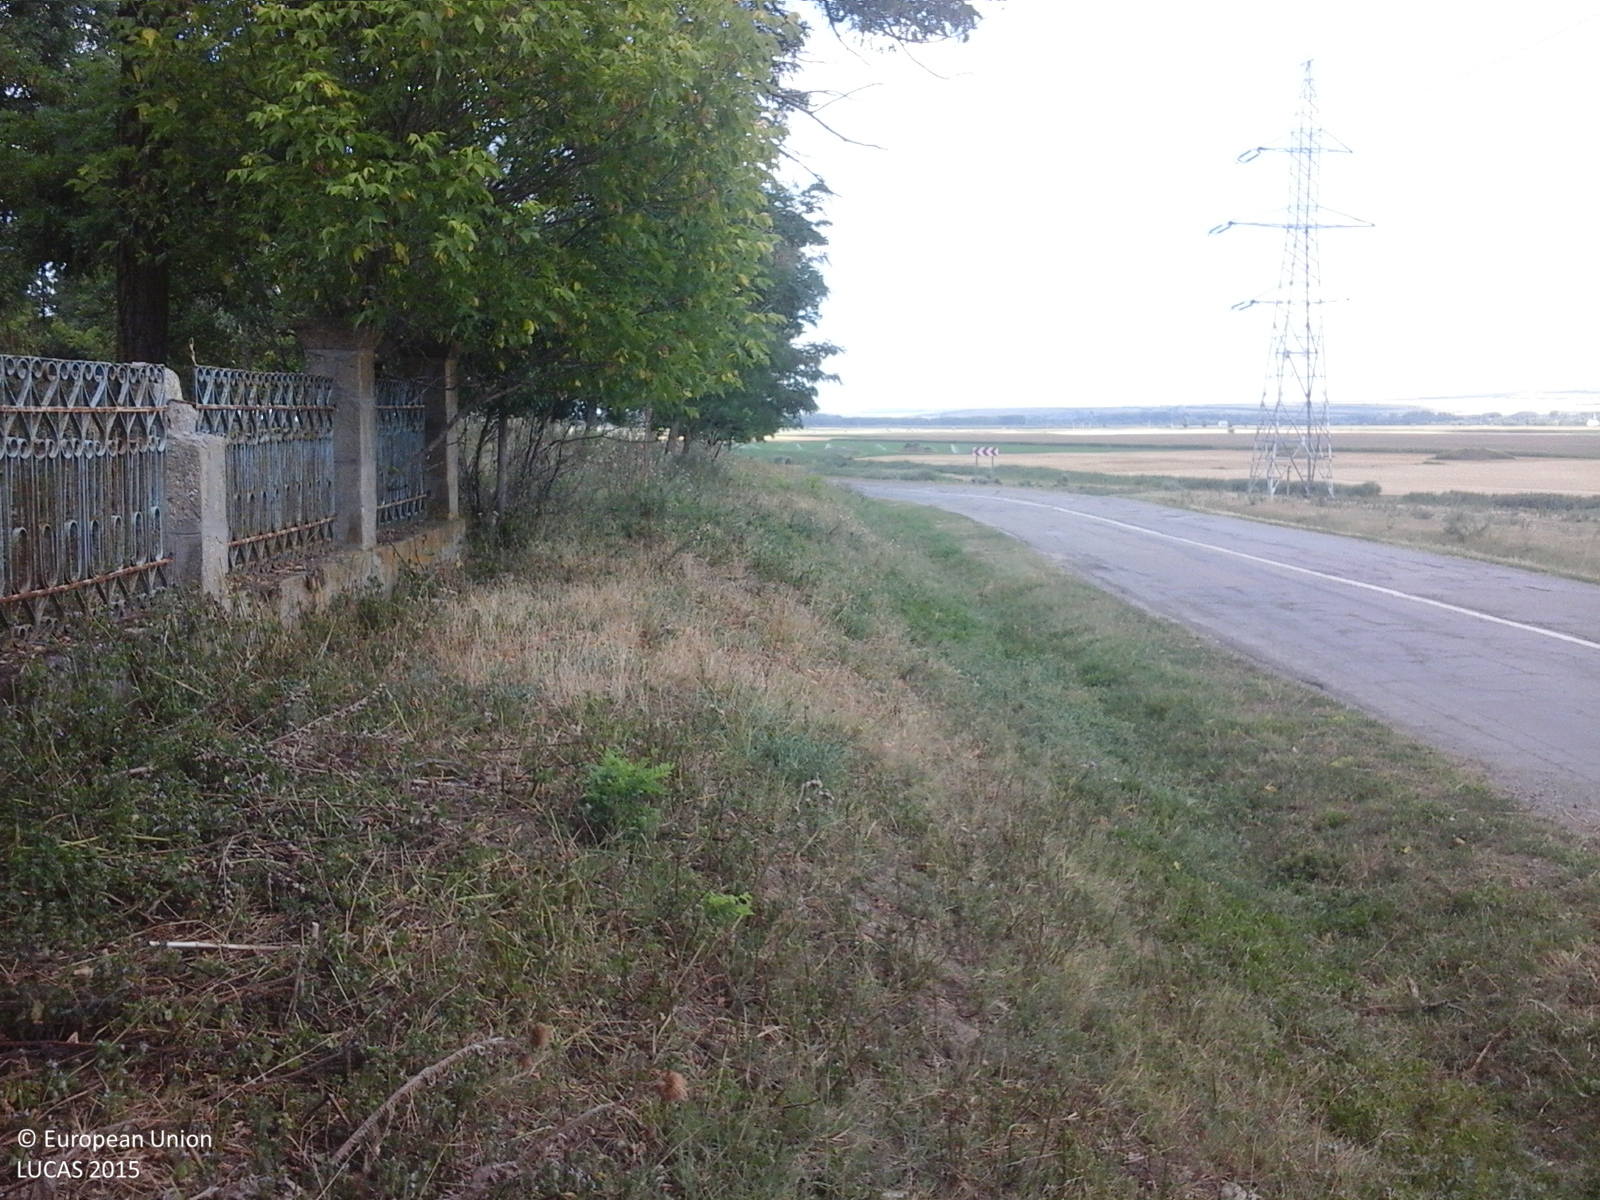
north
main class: Grassland
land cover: Grassland without tree/shrub cover
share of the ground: > 75 %
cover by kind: herbaceous plants 100 %
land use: Residential
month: July
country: RO
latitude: 46.4704
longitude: 28.1957
